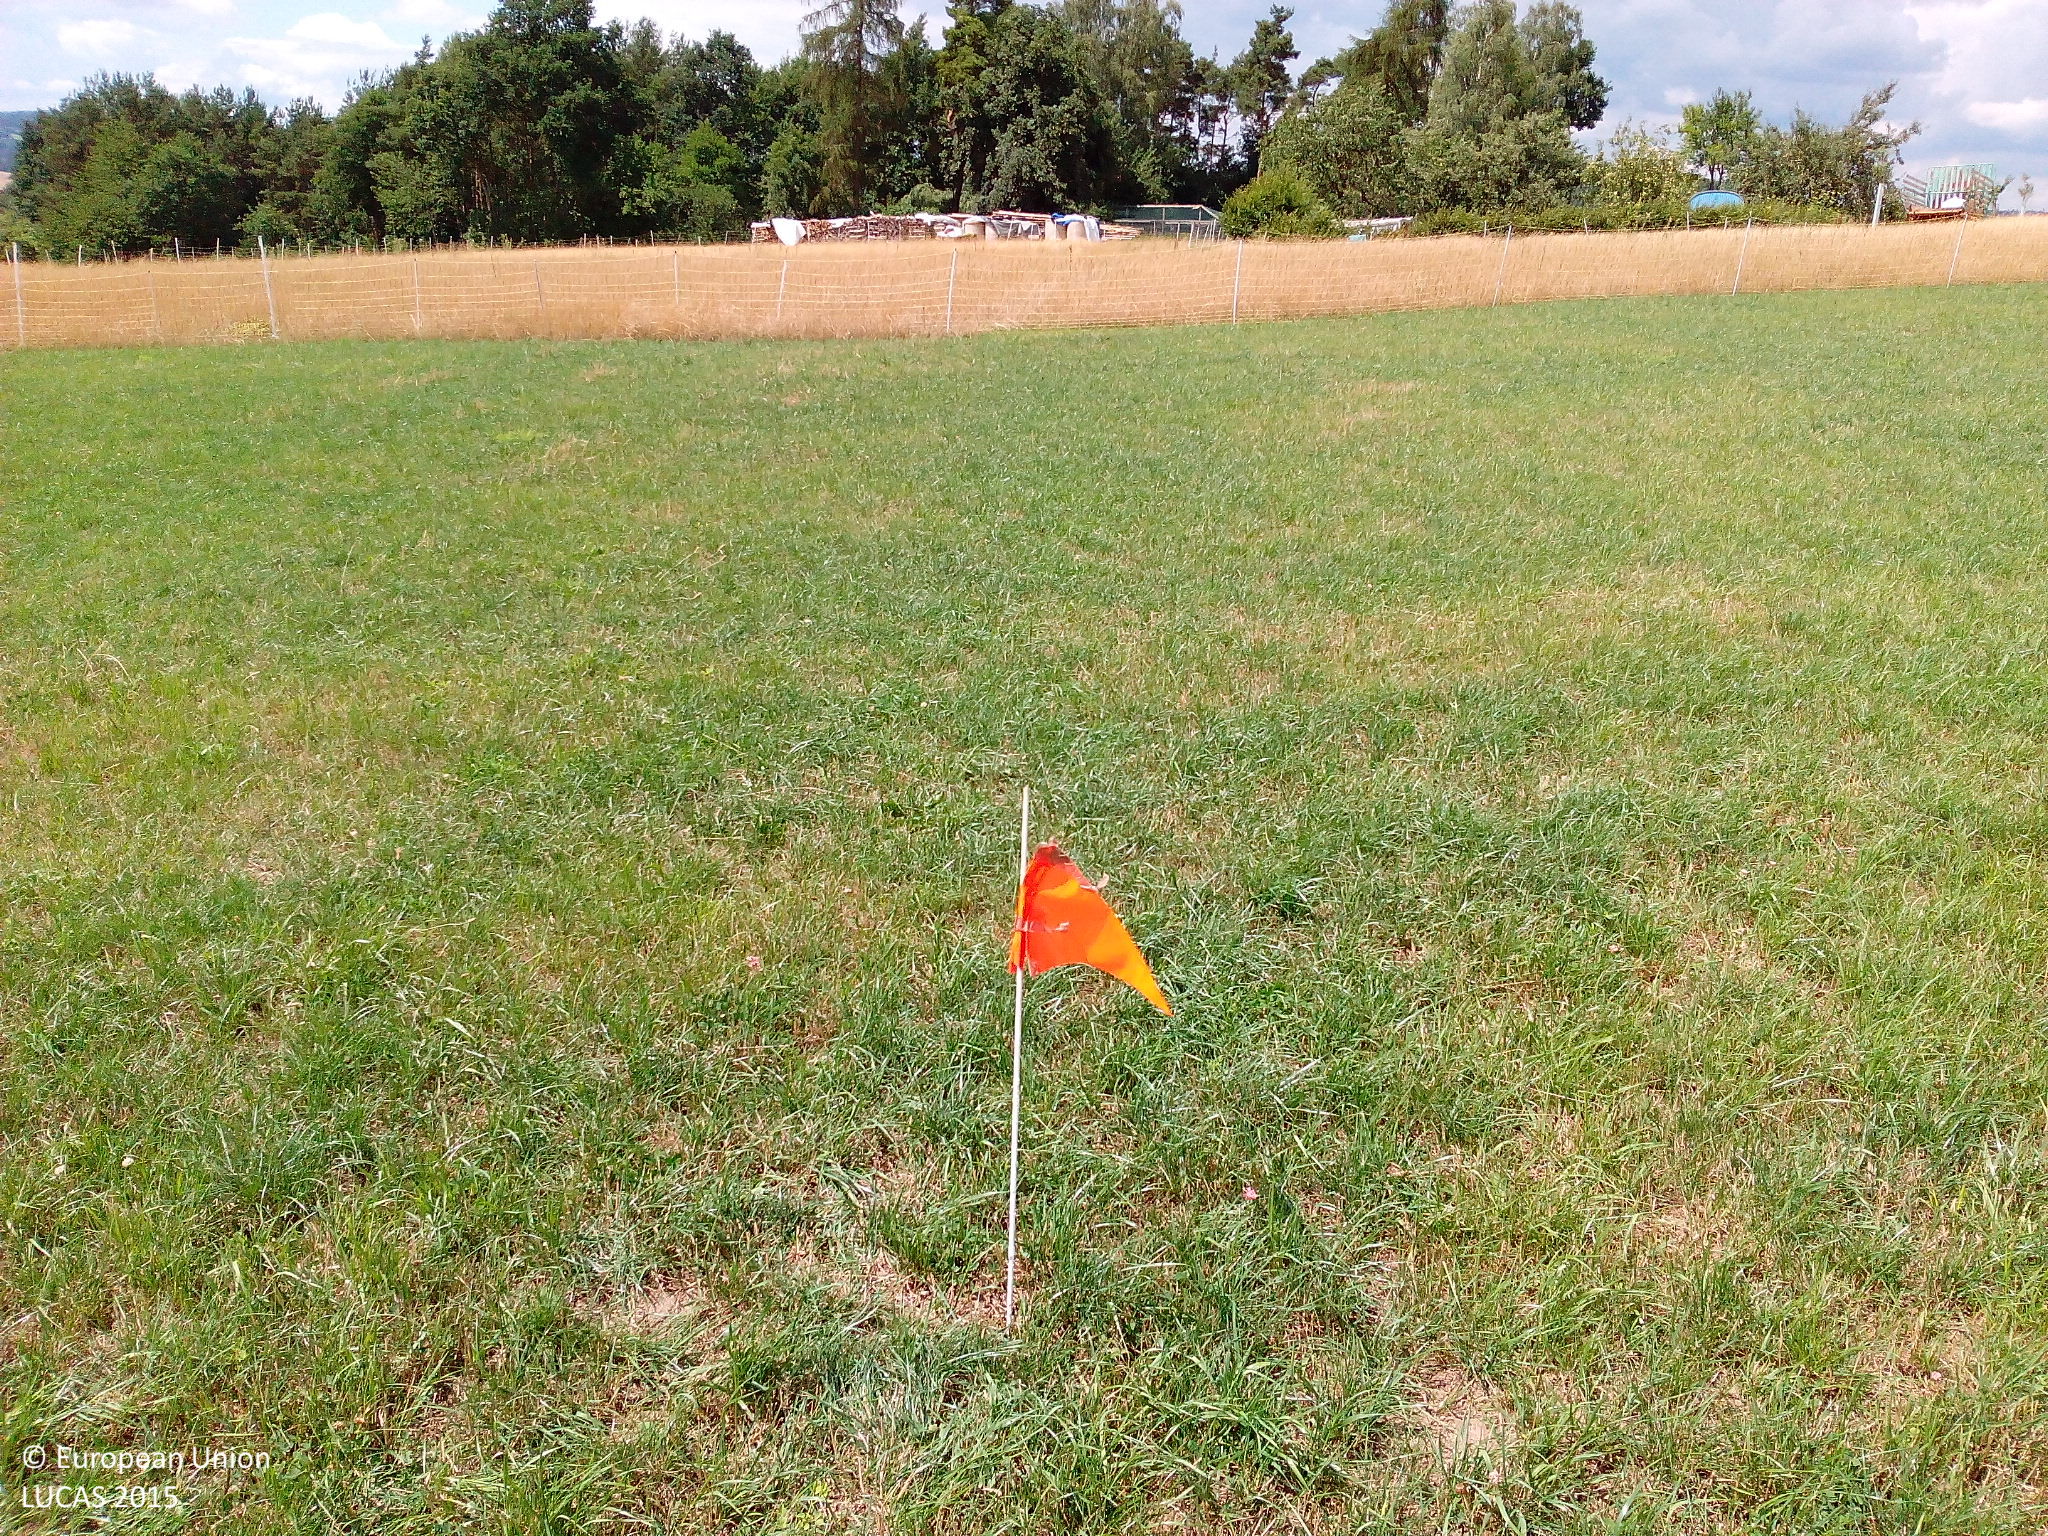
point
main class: Grassland
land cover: Grassland without tree/shrub cover
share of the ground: > 75 %
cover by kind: herbaceous plants 100 %
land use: Agriculture (excluding fallow land and kitchen gardens)
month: July
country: DE
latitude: 50.5791
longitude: 9.5906
